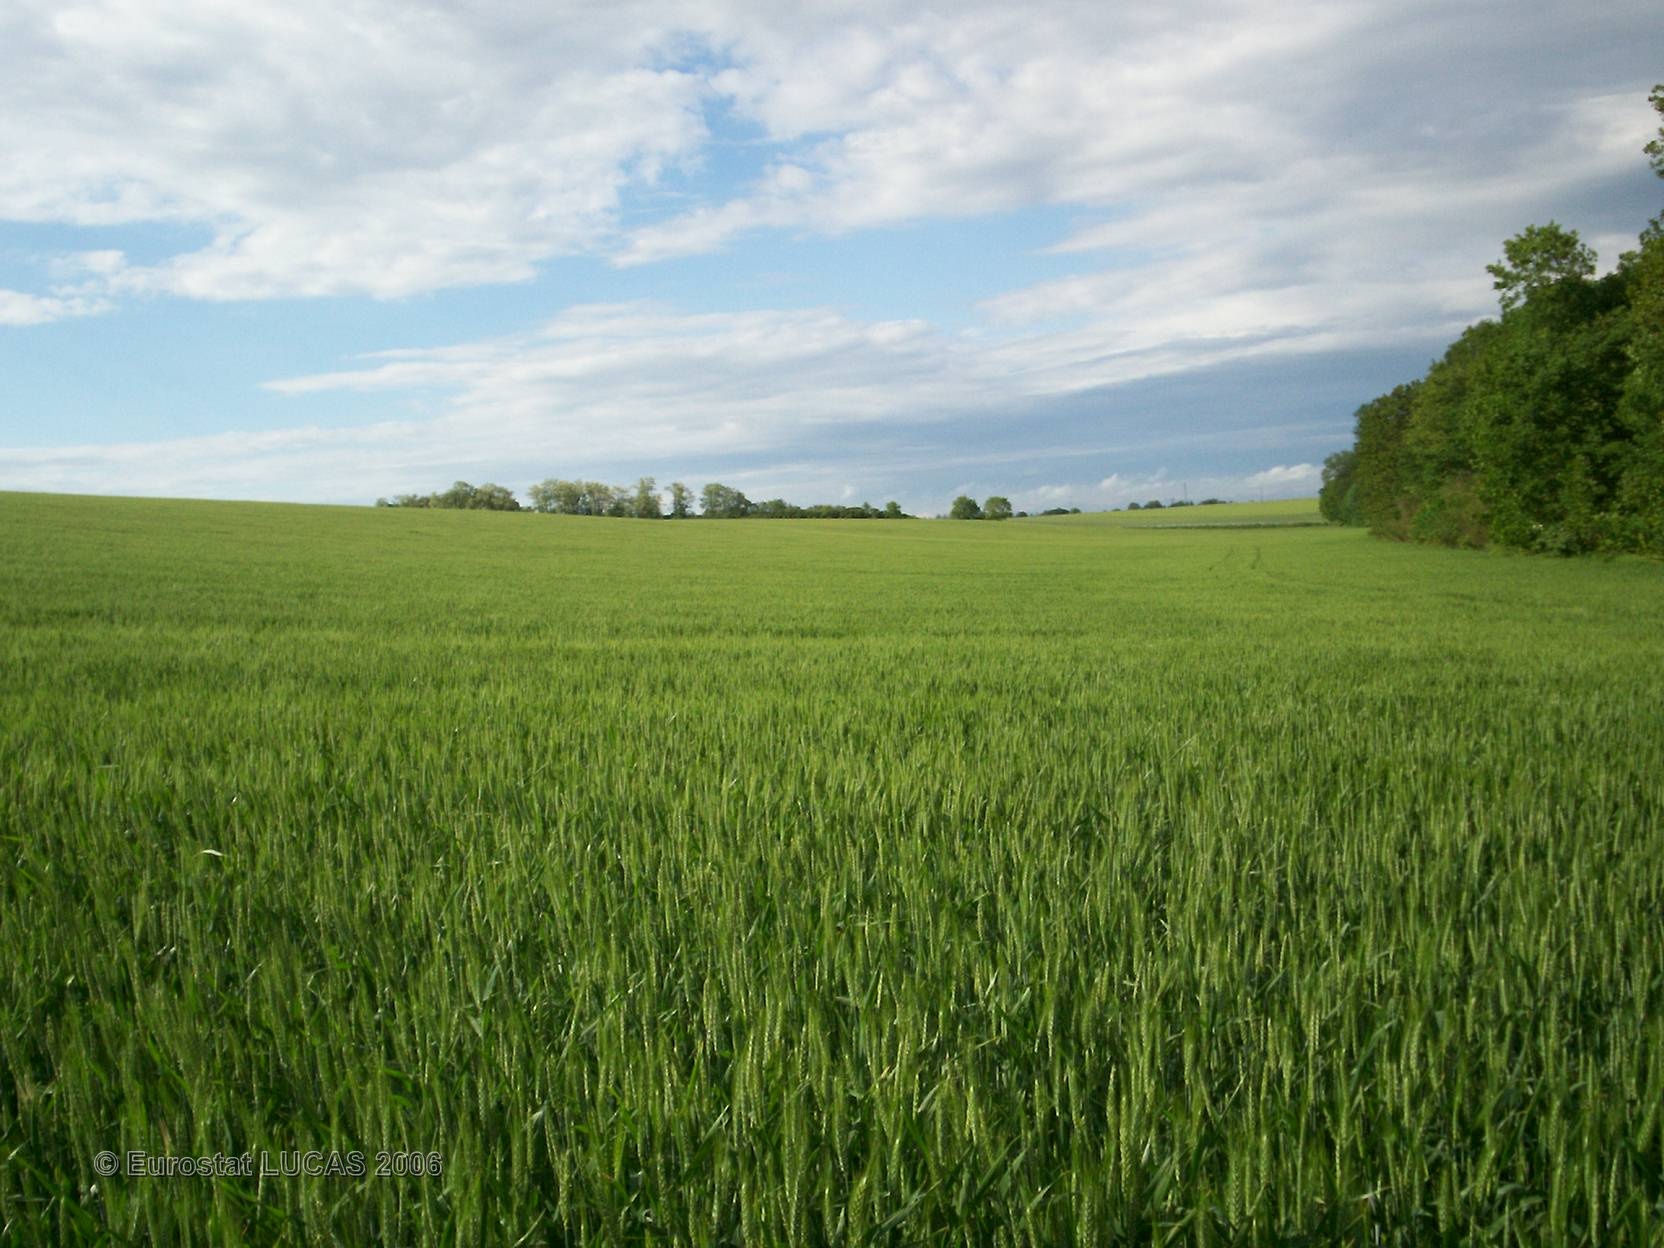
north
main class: Cropland
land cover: Common wheat
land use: Agriculture (excluding fallow land and kitchen gardens)
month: May
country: FR
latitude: 48.9074
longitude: 2.7727
